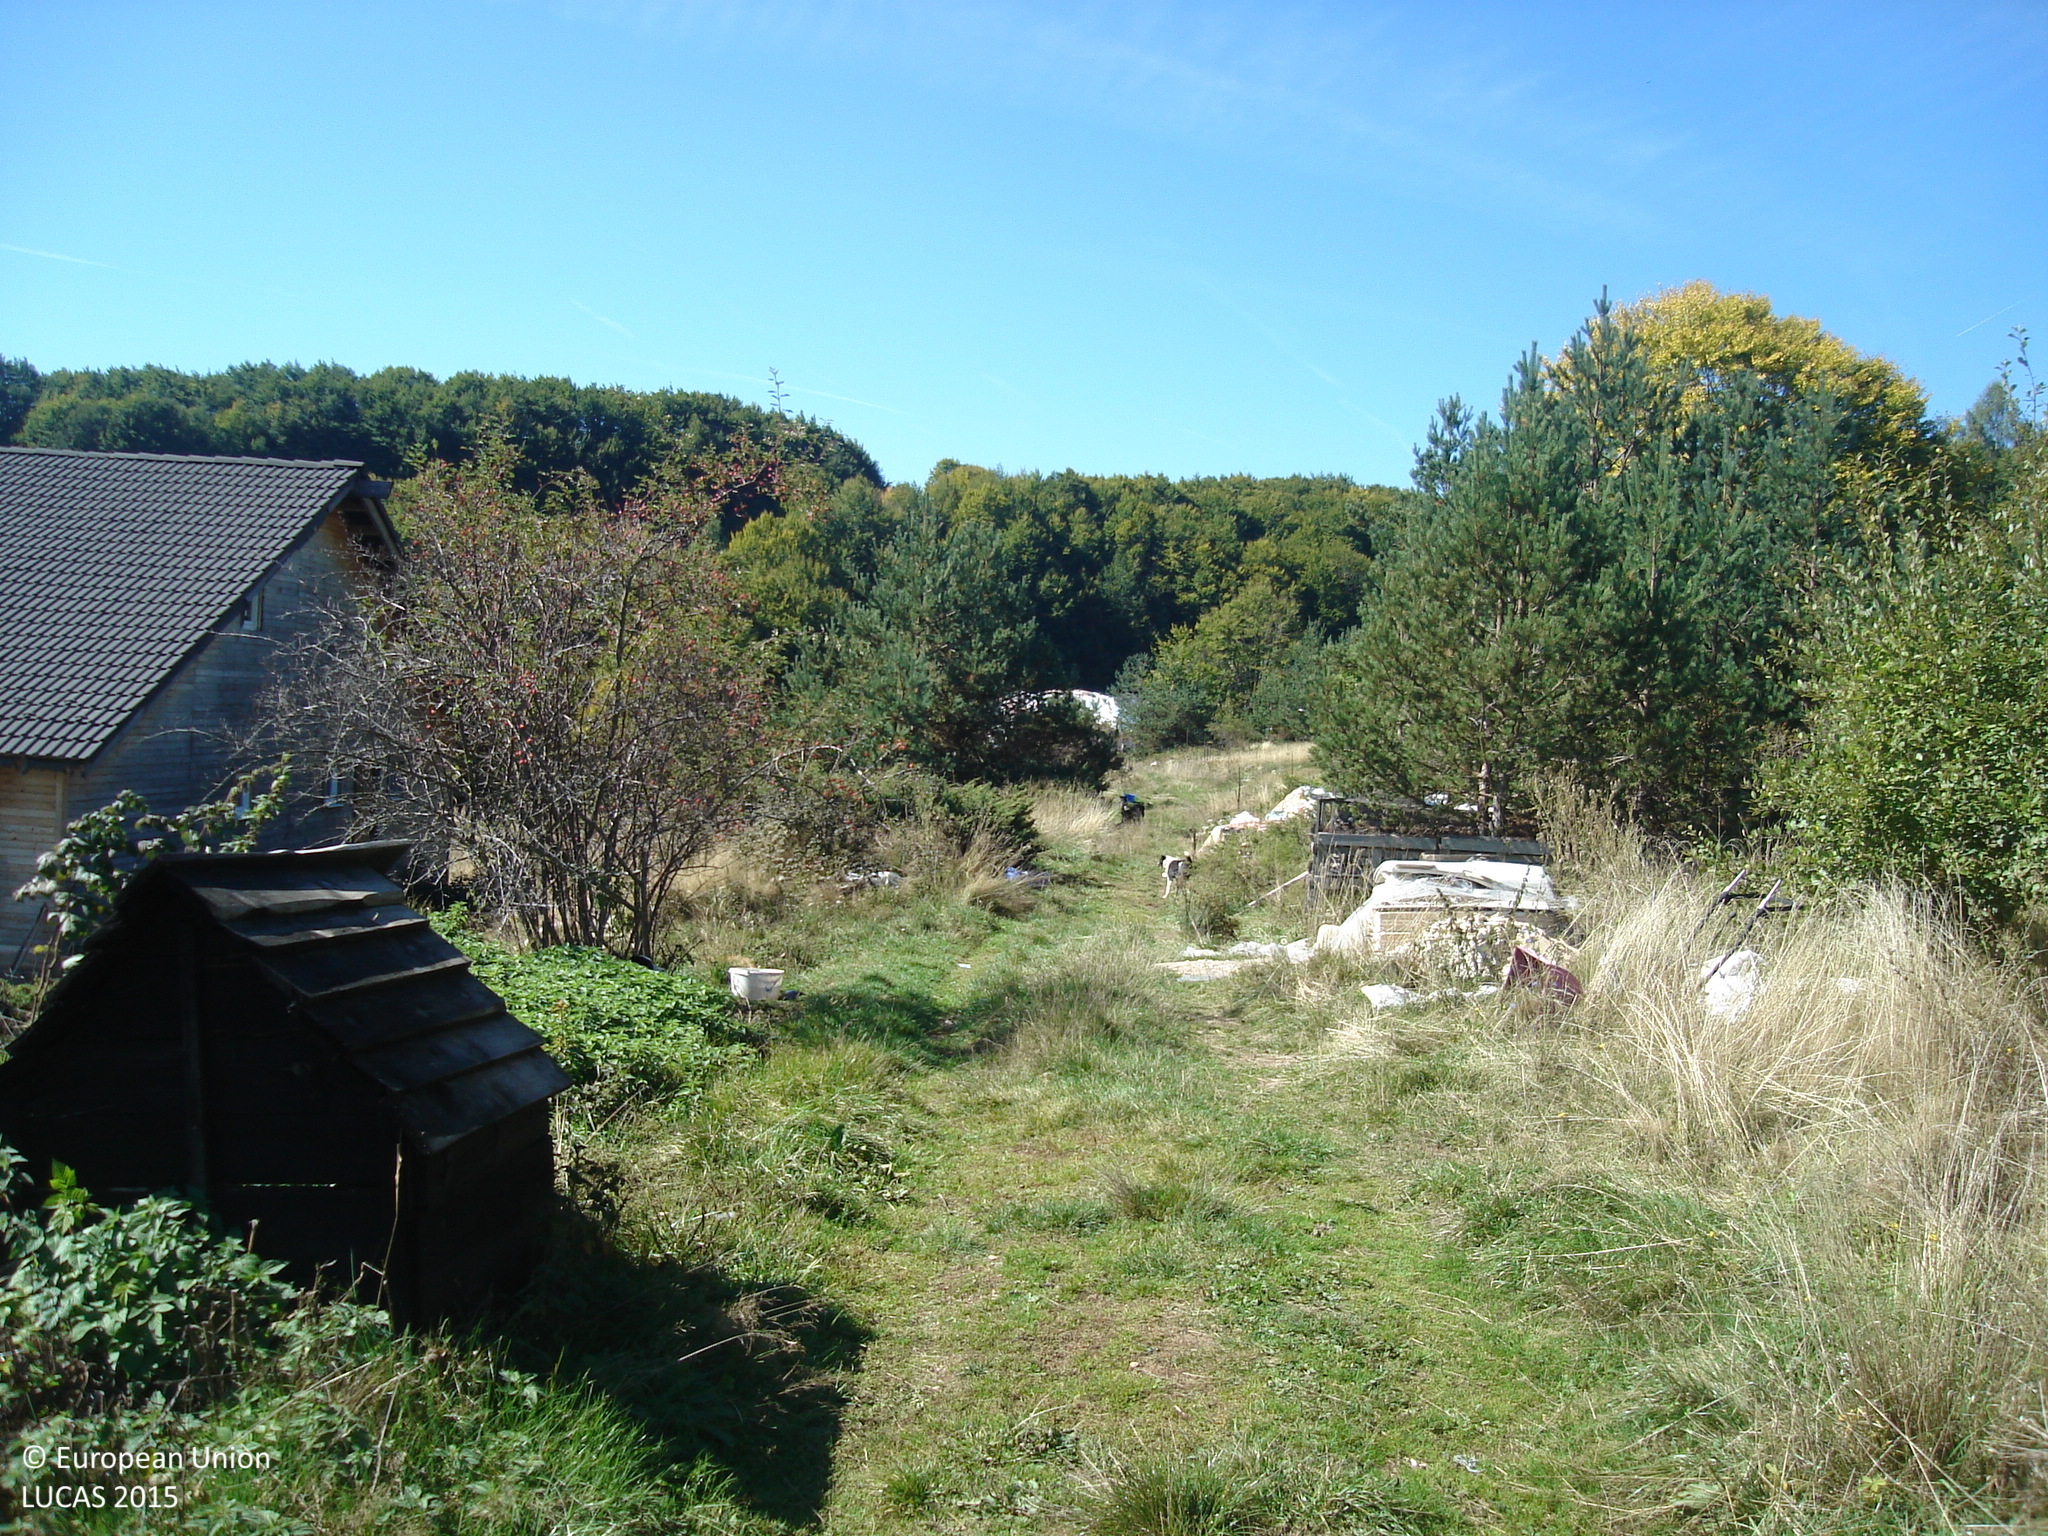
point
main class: Grassland
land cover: Grassland with sparse tree/shrub cover
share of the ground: 50 - 75 %
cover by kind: herbaceous plants 55 %, coniferous forest trees 5 %
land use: Residential
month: October
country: BG
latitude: 43.1082
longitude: 23.1473
